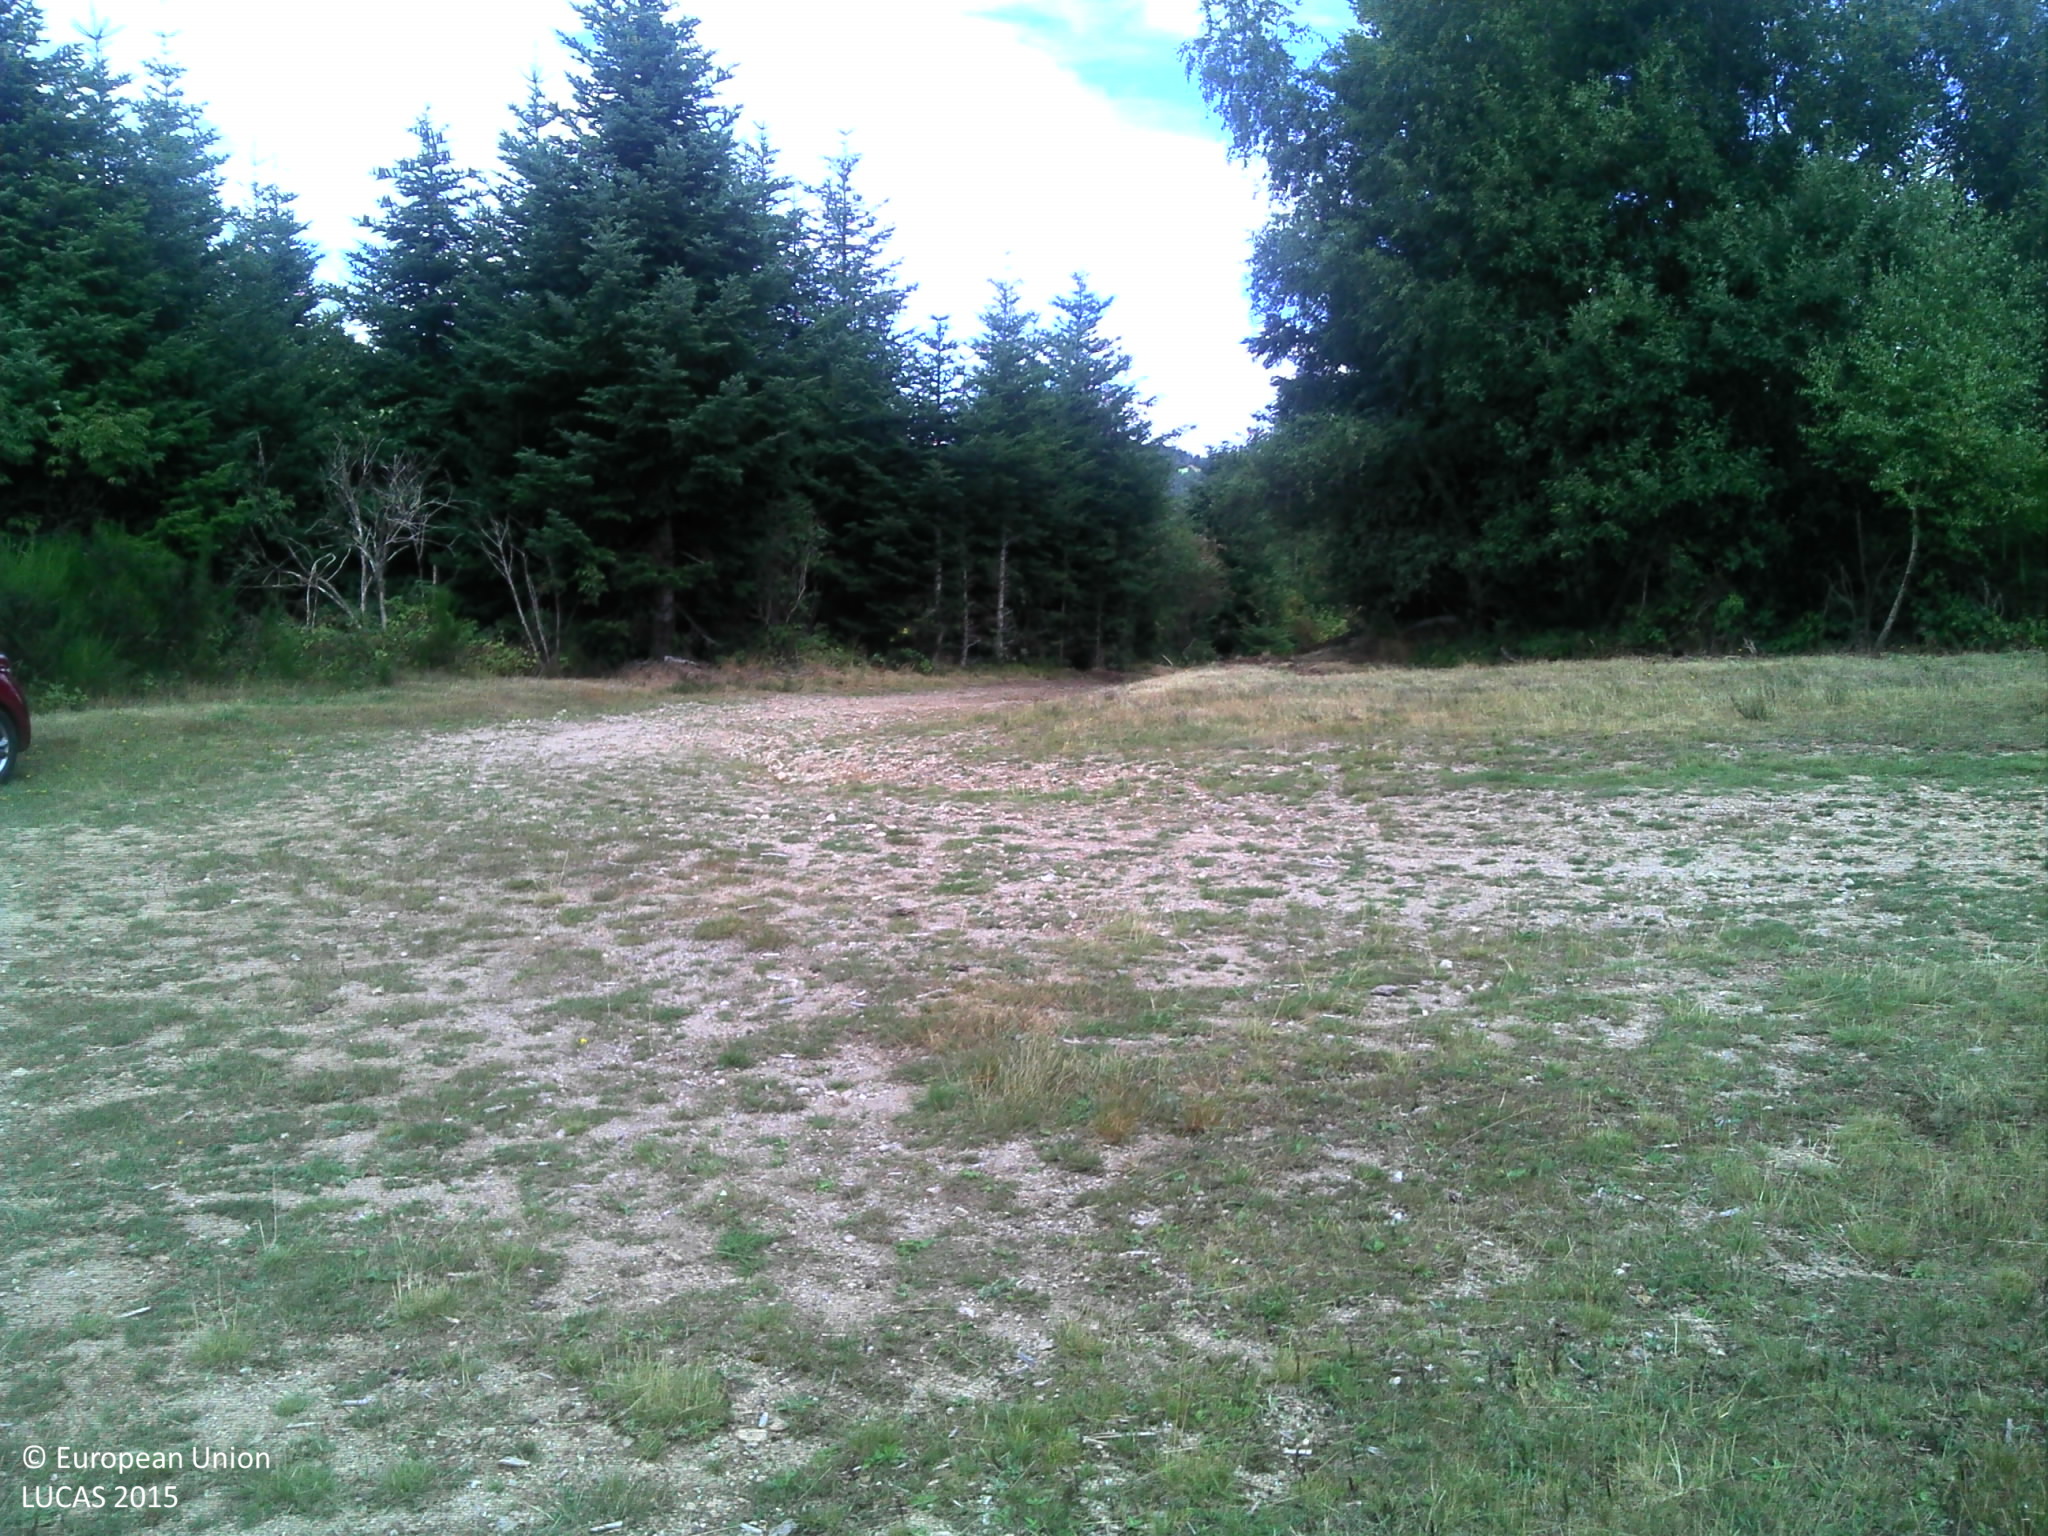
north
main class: Shrubland
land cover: Shrubland without tree cover
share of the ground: > 75 %
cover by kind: shrubs 95 %, unconsolidated bare surface 5 %
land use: Semi-natural and natural areas not in use
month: August
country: FR
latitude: 45.1096
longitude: 4.5268
